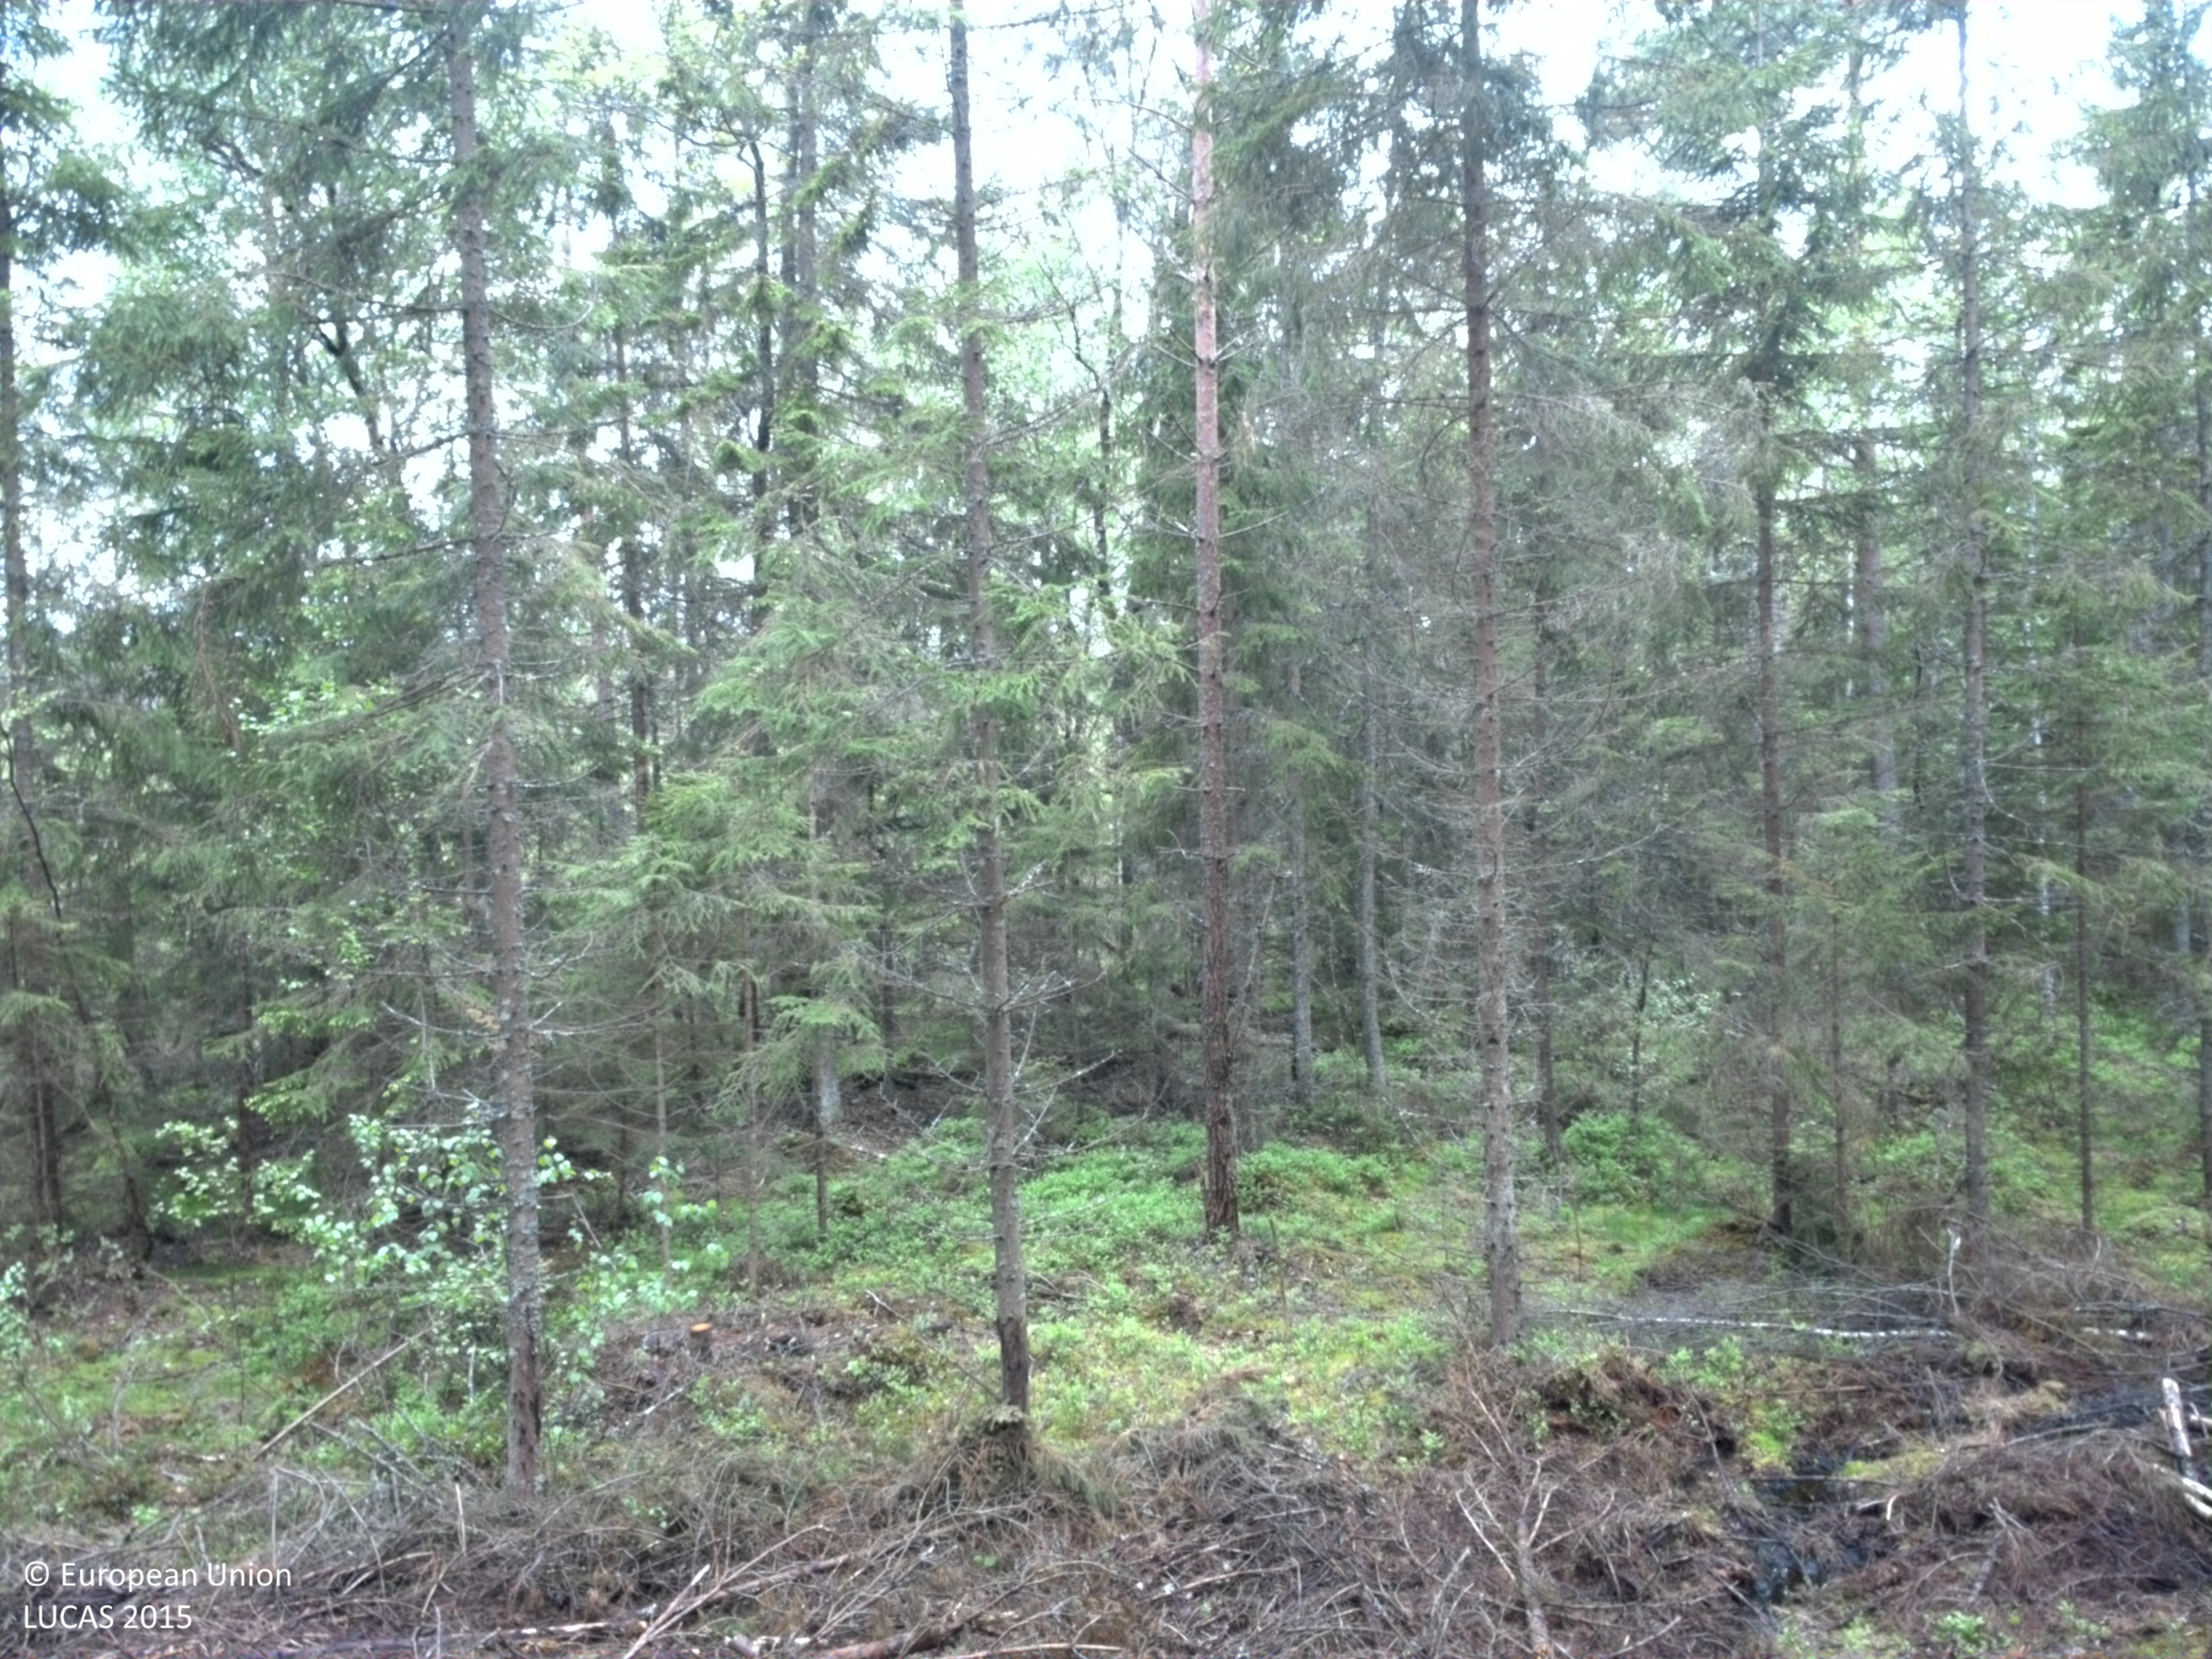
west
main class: Woodland
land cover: Spruce dominated coniferous woodland
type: boreal forest
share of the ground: 50 - 75 %
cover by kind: coniferous forest trees 50 %, shrubs 25 %, lichens and mosses 15 %, broadleaved forest trees 5 %, herbaceous plants 5 %
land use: Forestry
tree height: > 5 m
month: June
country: SE
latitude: 56.7640
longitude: 14.2994
